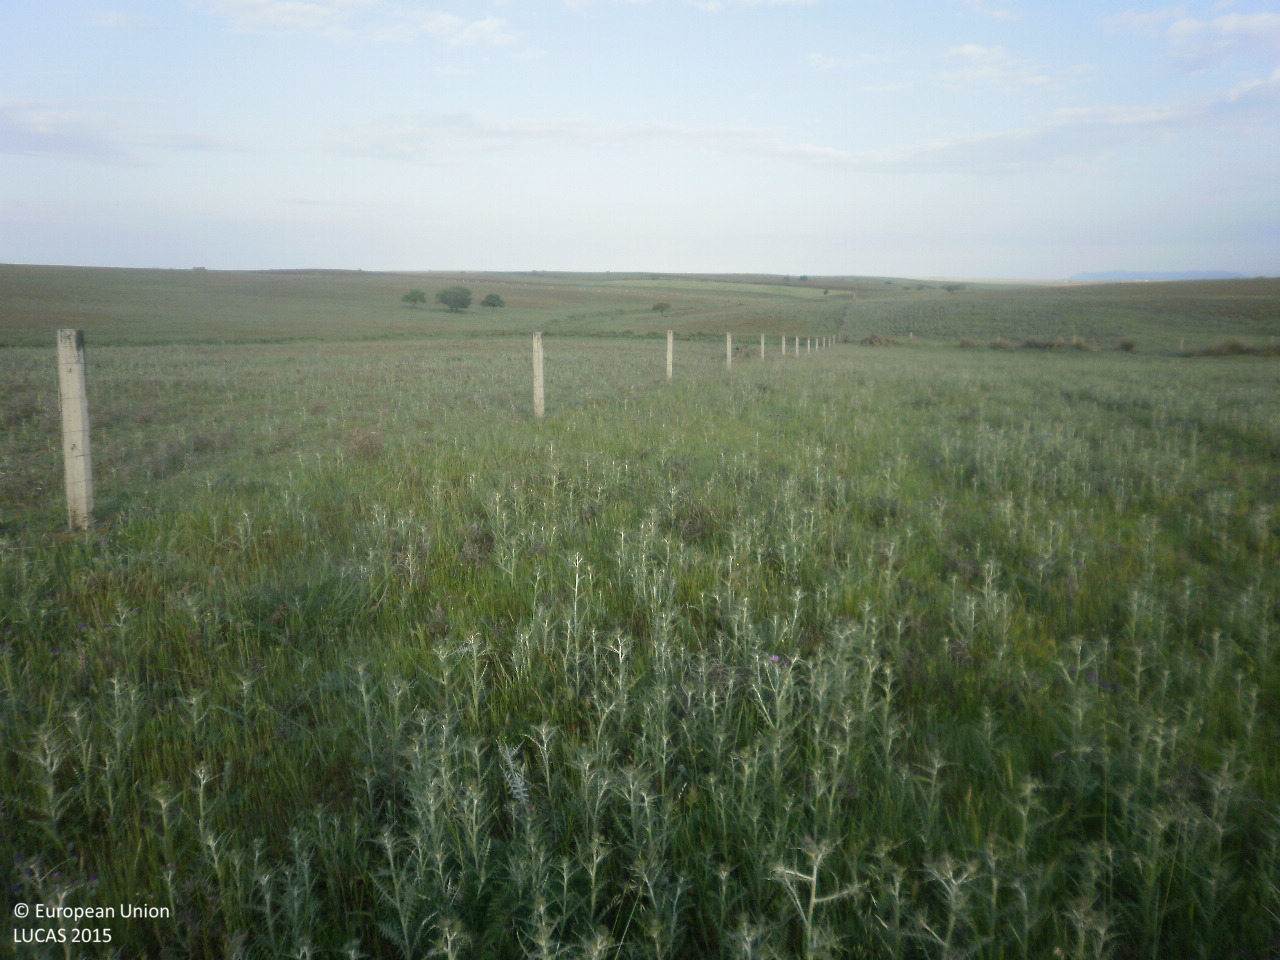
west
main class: Grassland
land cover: Grassland without tree/shrub cover
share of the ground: > 75 %
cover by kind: herbaceous plants 100 %
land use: Agriculture (excluding fallow land and kitchen gardens)
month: April
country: ES
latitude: 38.8209
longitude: -5.1814
